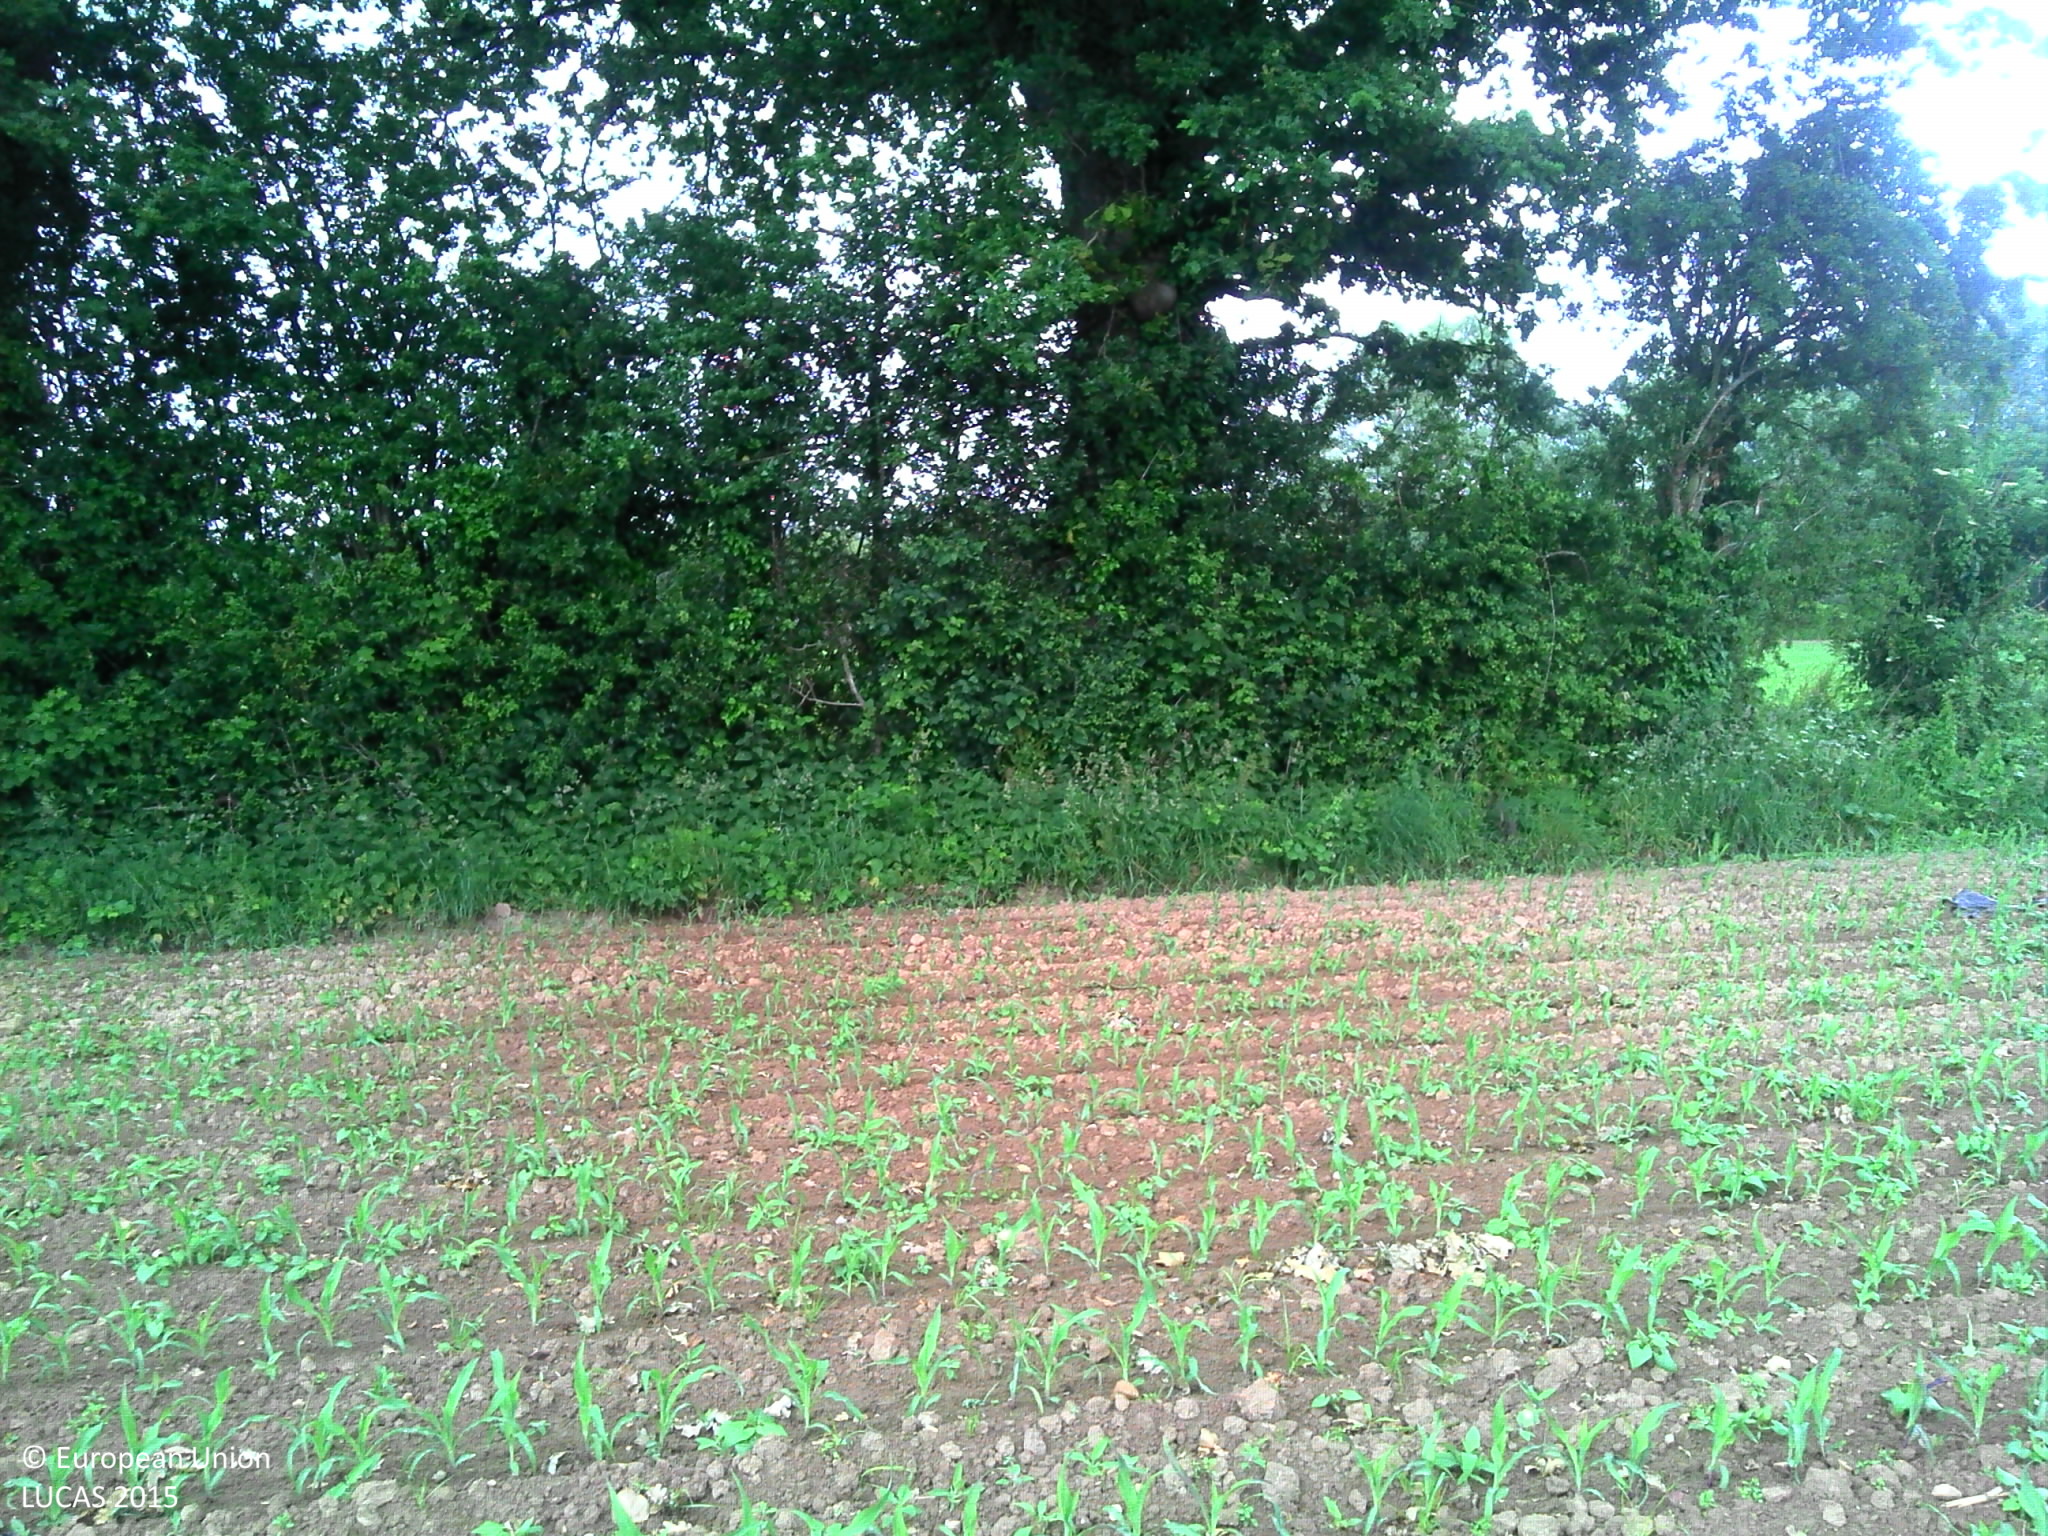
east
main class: Cropland
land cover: Maize
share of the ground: 10 - 25 %
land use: Agriculture (excluding fallow land and kitchen gardens)
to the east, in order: Maize; Grass margins; Broadleaved woodland; Maize; Broadleaved woodland; Grassland without tree/shrub cover; Fences; Rivers and streams; Spontaneously vegetated surfaces; Grassland without tree/shrub cover
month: June
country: FR
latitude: 49.4329
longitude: -1.5361
